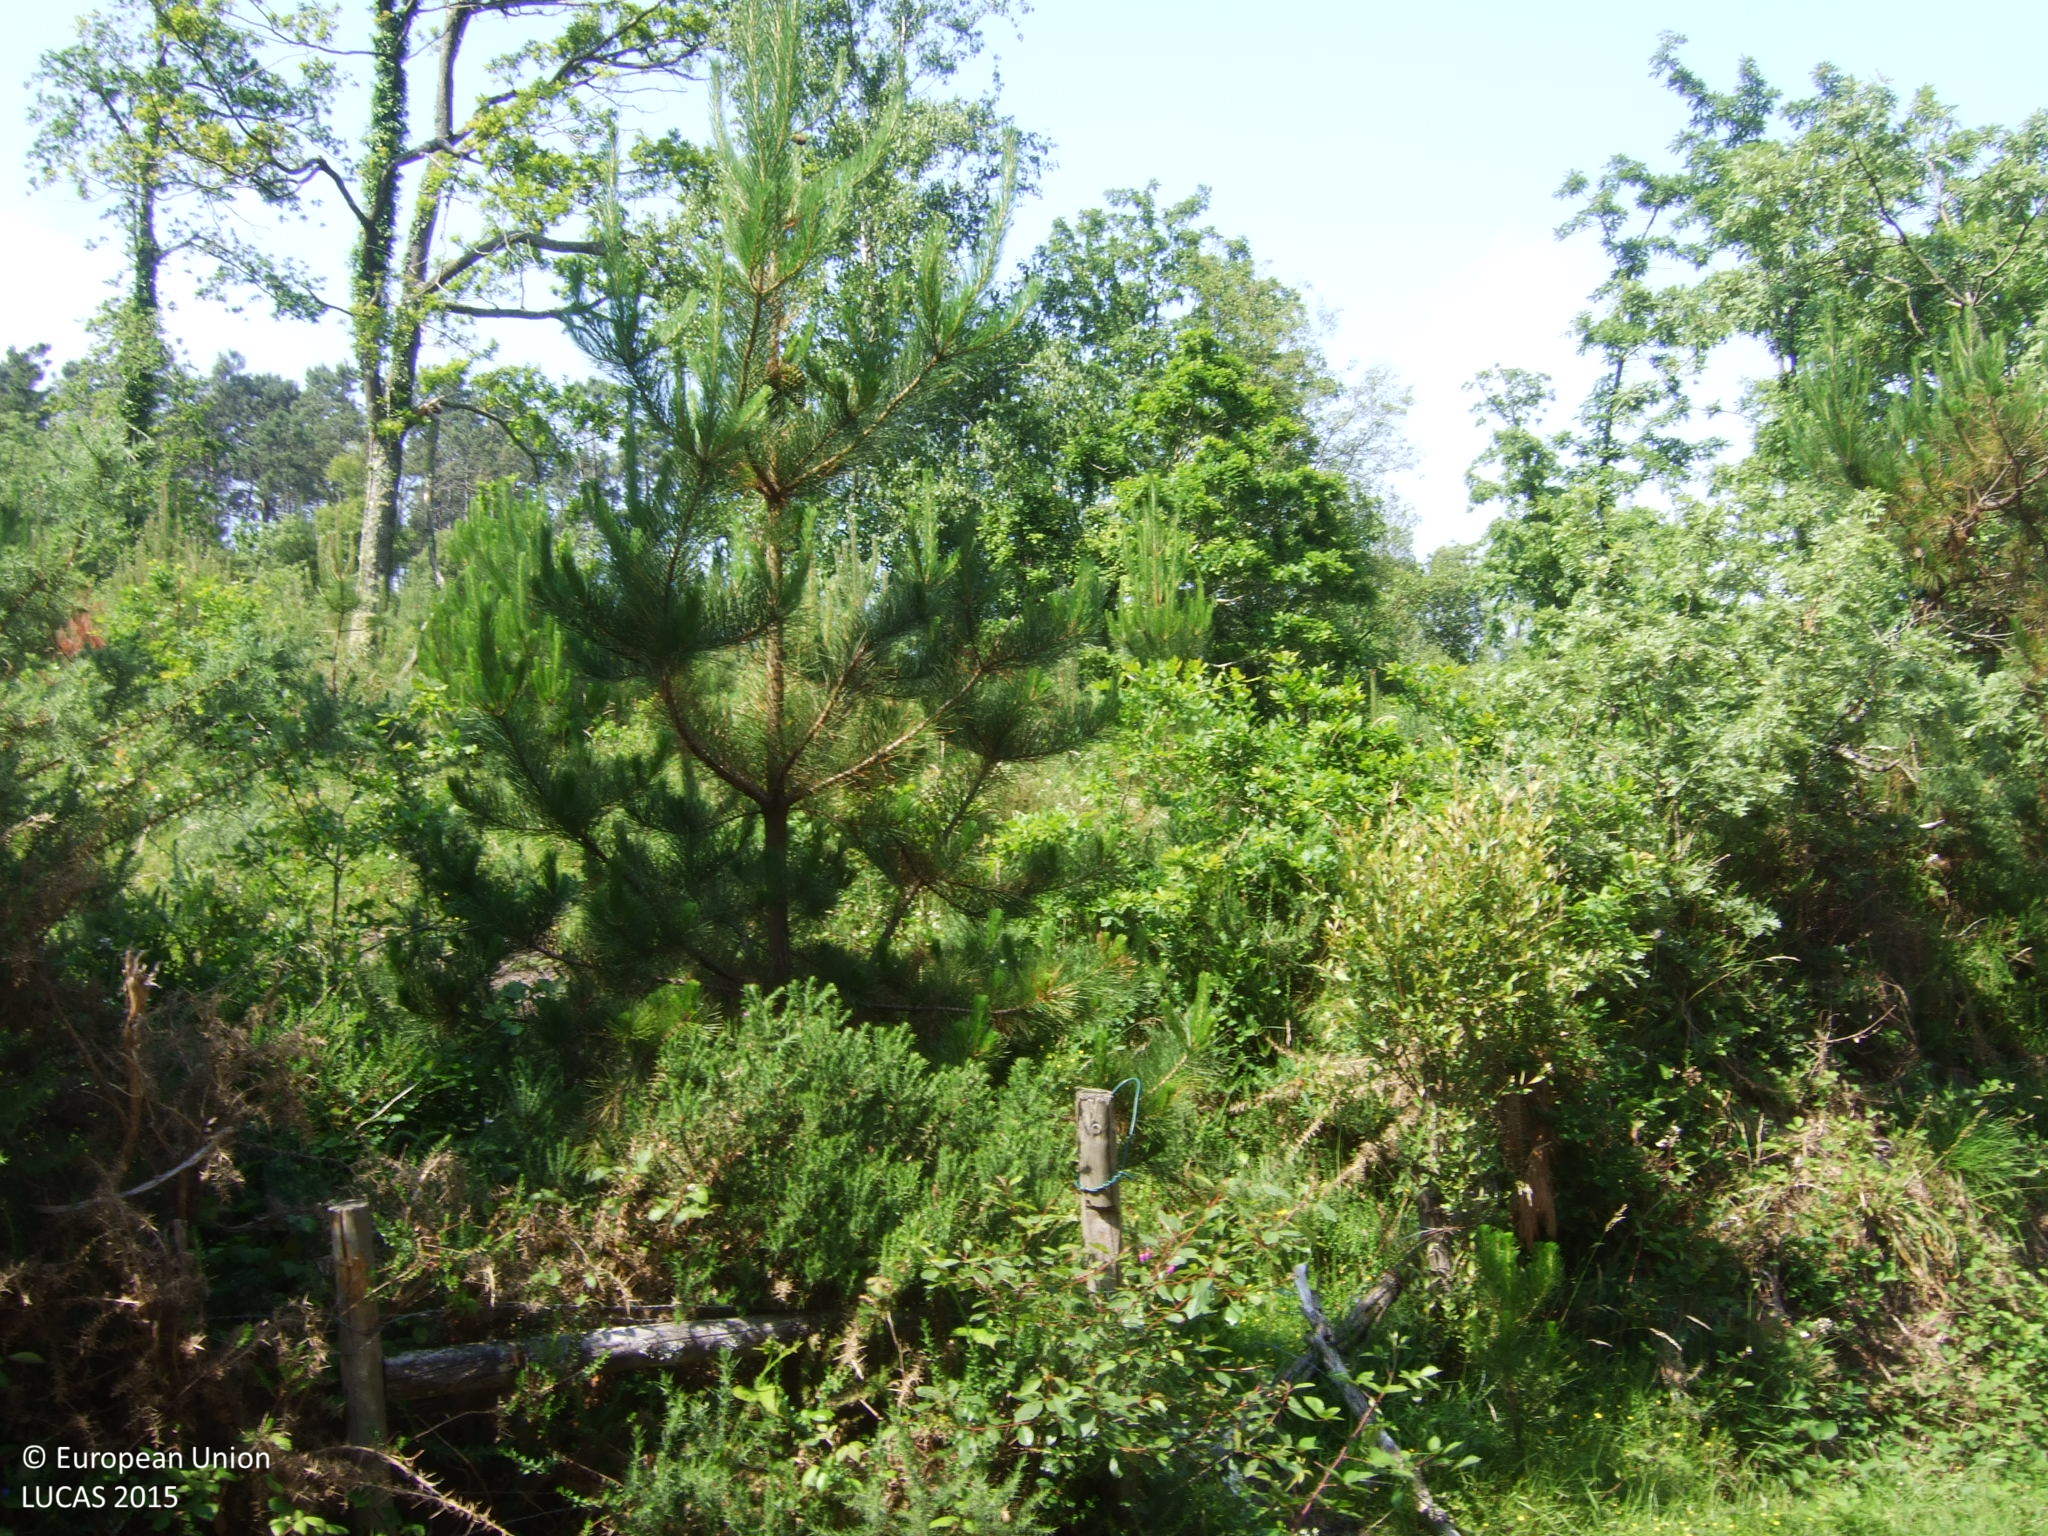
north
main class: Woodland
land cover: Broadleaved woodland
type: acidophilous oak and oak-birch forest
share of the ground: > 75 %
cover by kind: broadleaved forest trees 85 %, shrubs 15 %
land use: Forestry
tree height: > 5 m
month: June
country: ES
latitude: 43.5805
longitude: -7.5324
